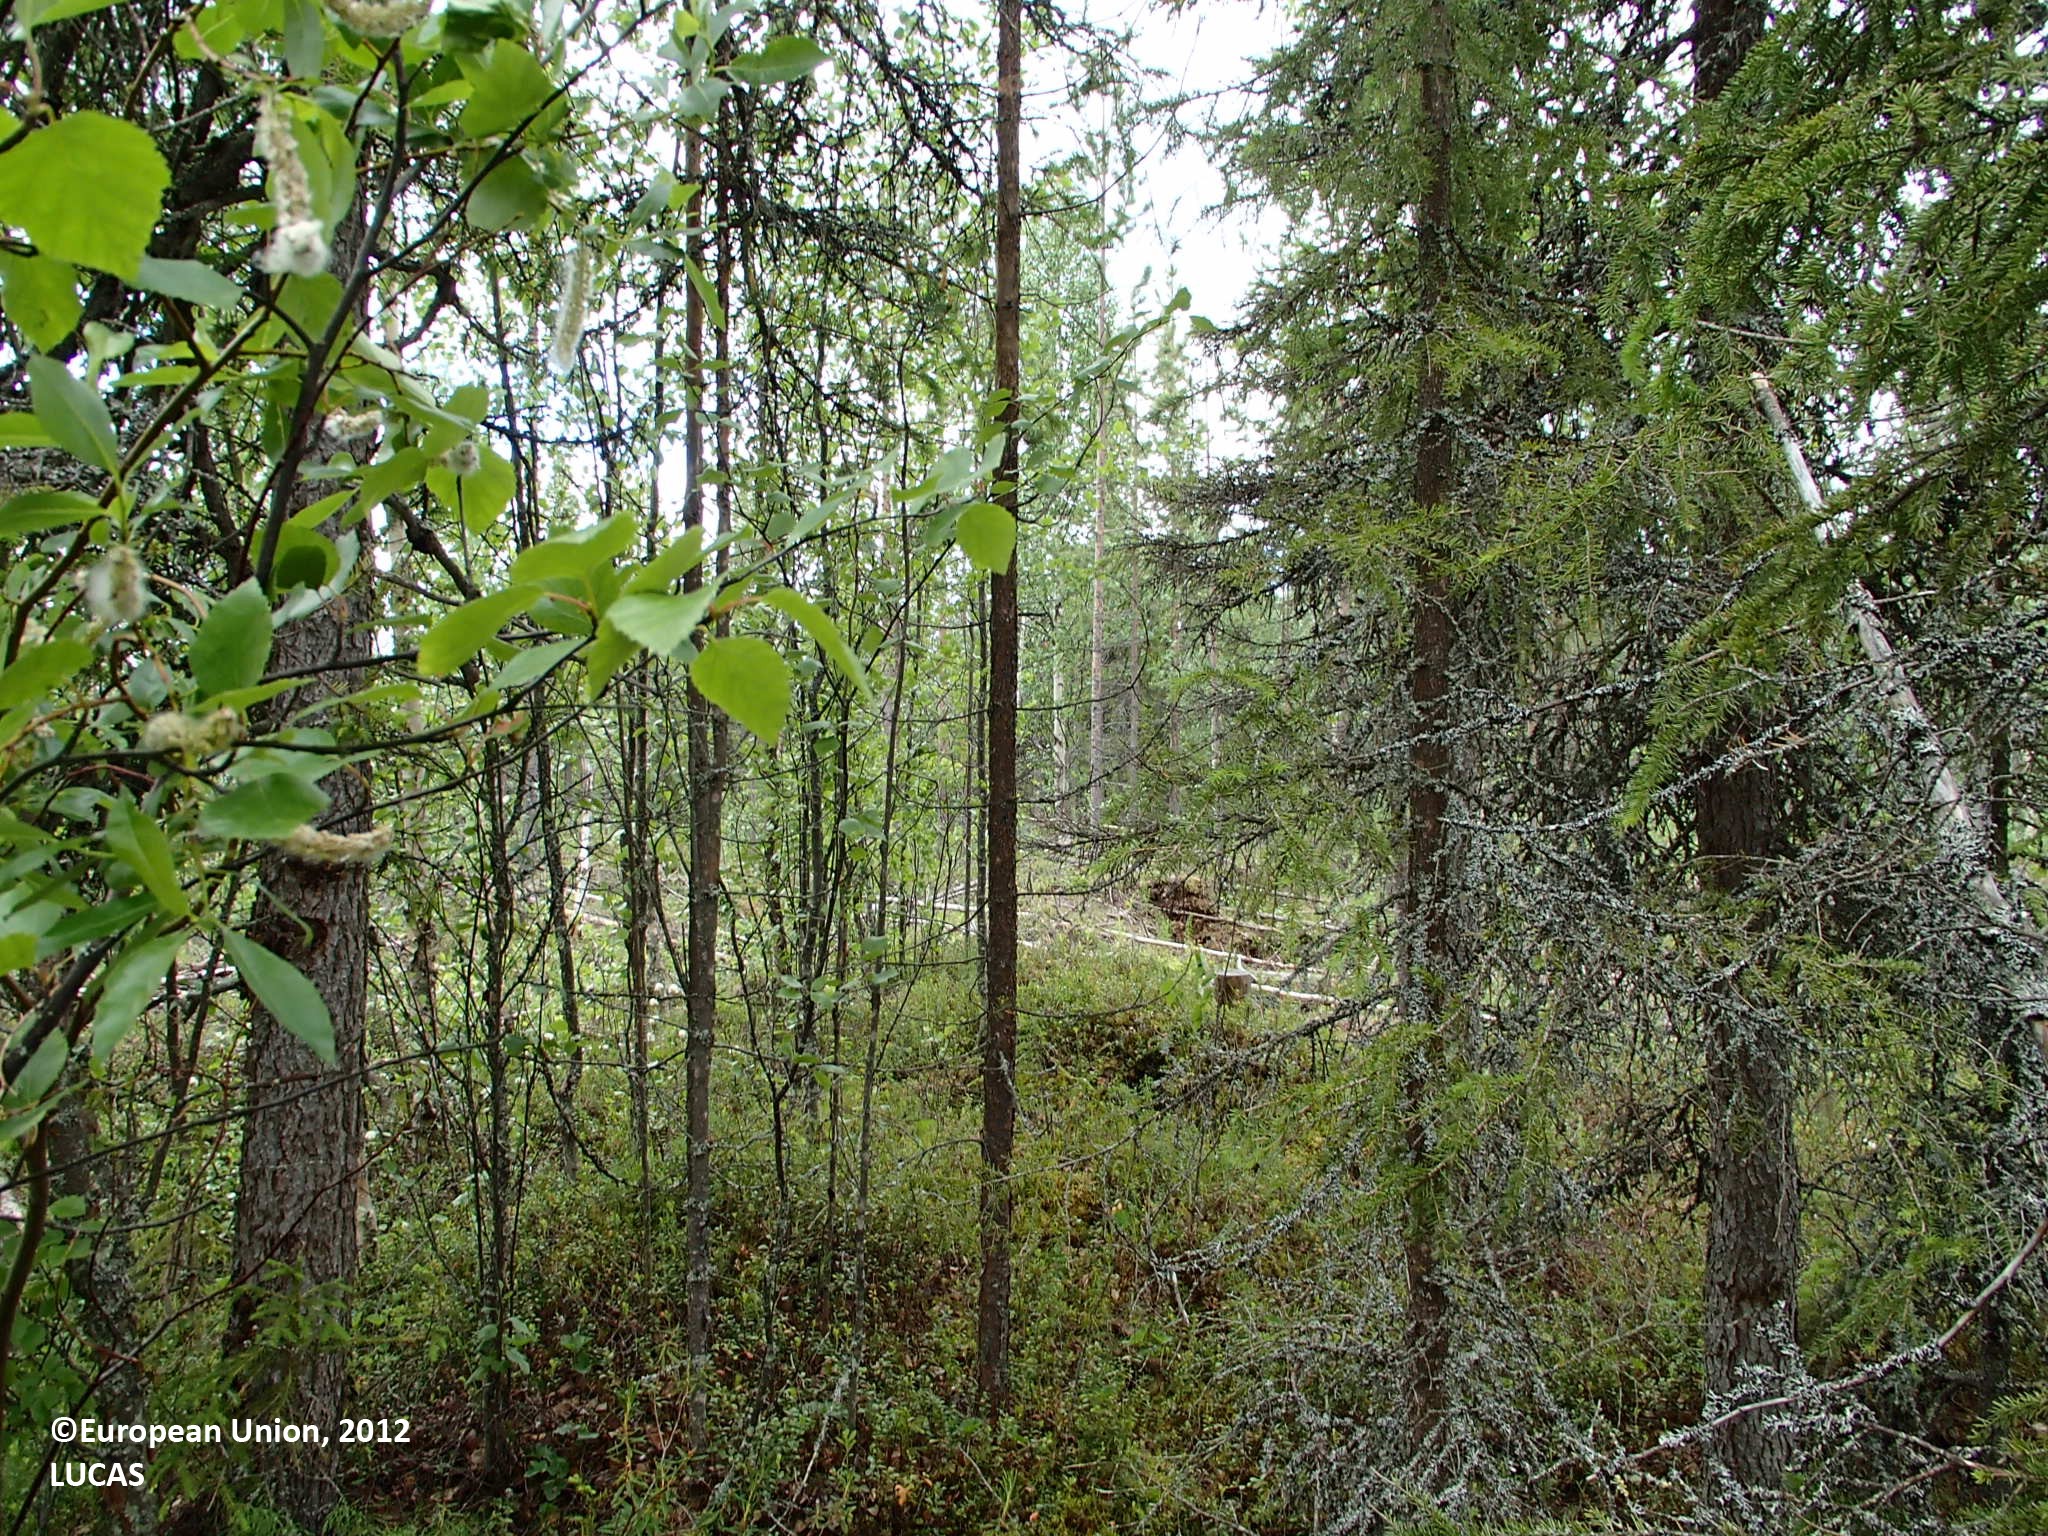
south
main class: Woodland
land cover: Spruce dominated coniferous woodland
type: boreal forest
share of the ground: > 75 %
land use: Forestry
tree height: > 5 m
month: July
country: FI
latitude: 66.9462
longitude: 27.9471
